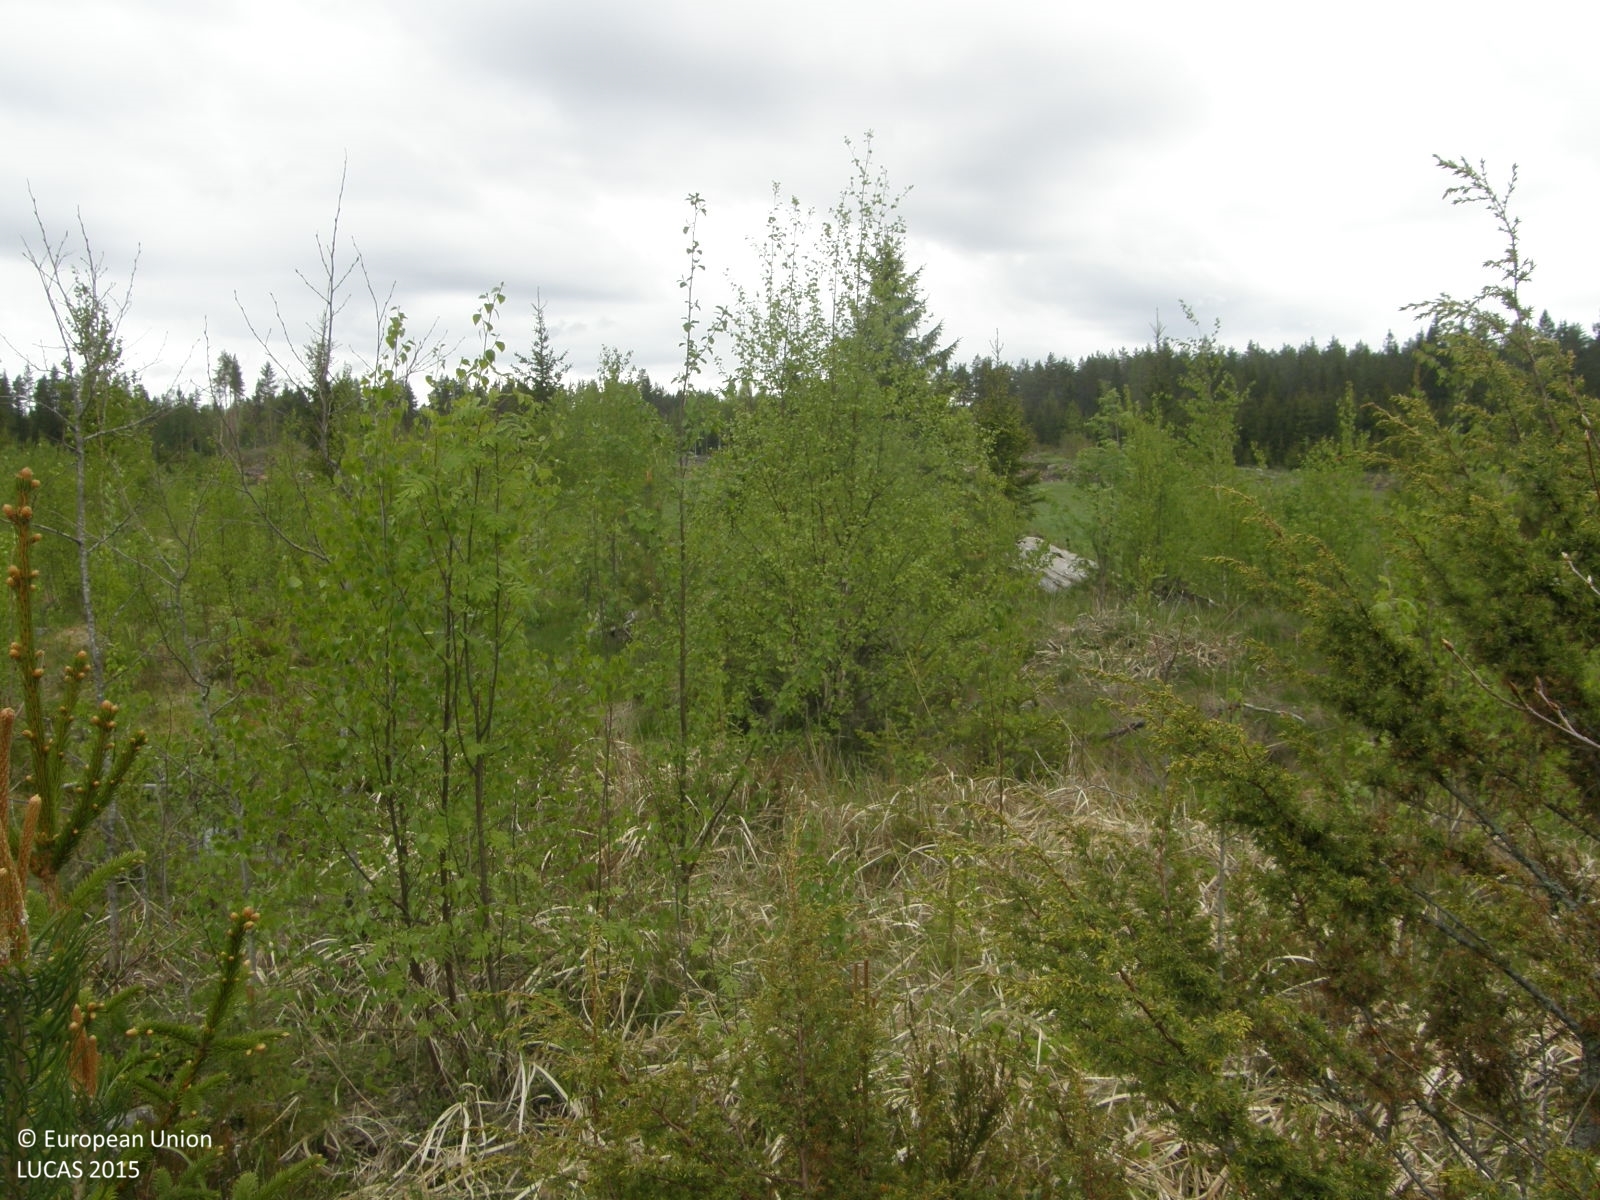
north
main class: Woodland
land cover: Other mixed woodland
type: boreal forest
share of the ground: 50 - 75 %
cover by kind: broadleaved forest trees 40 %, coniferous forest trees 25 %, herbaceous plants 20 %, shrubs 10 %, lichens and mosses 5 %
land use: Forestry
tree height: < 5 m
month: June
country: FI
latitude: 62.0189
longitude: 21.5683
